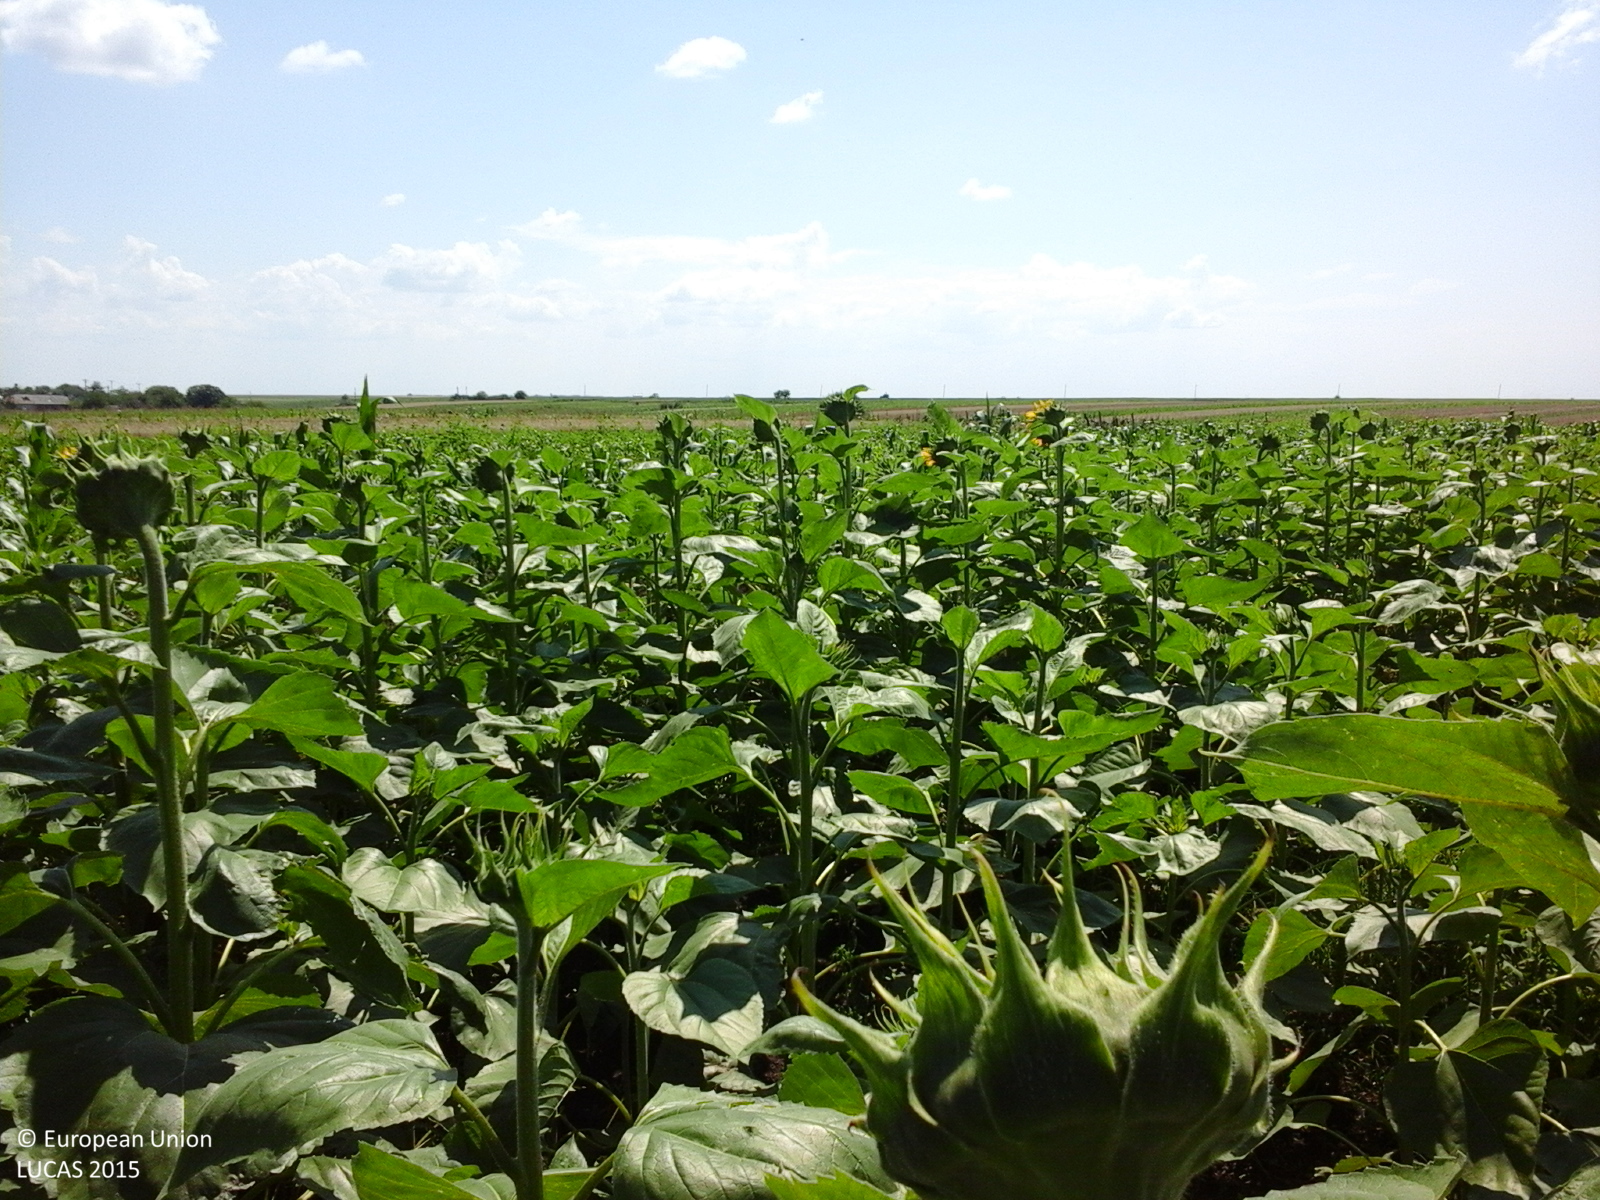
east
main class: Cropland
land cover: Sunflower
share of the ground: > 75 %
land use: Agriculture (excluding fallow land and kitchen gardens)
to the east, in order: Sunflower; Maize; Grass margins; Maize; Sunflower; Grass margins; Lucerne; Common wheat; Maize; Sunflower; Common wheat; Maize; Sunflower; Maize; Common wheat; Sunflower; Common wheat; Other bare soil; Common wheat
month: July
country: RO
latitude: 44.2013
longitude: 24.7768
